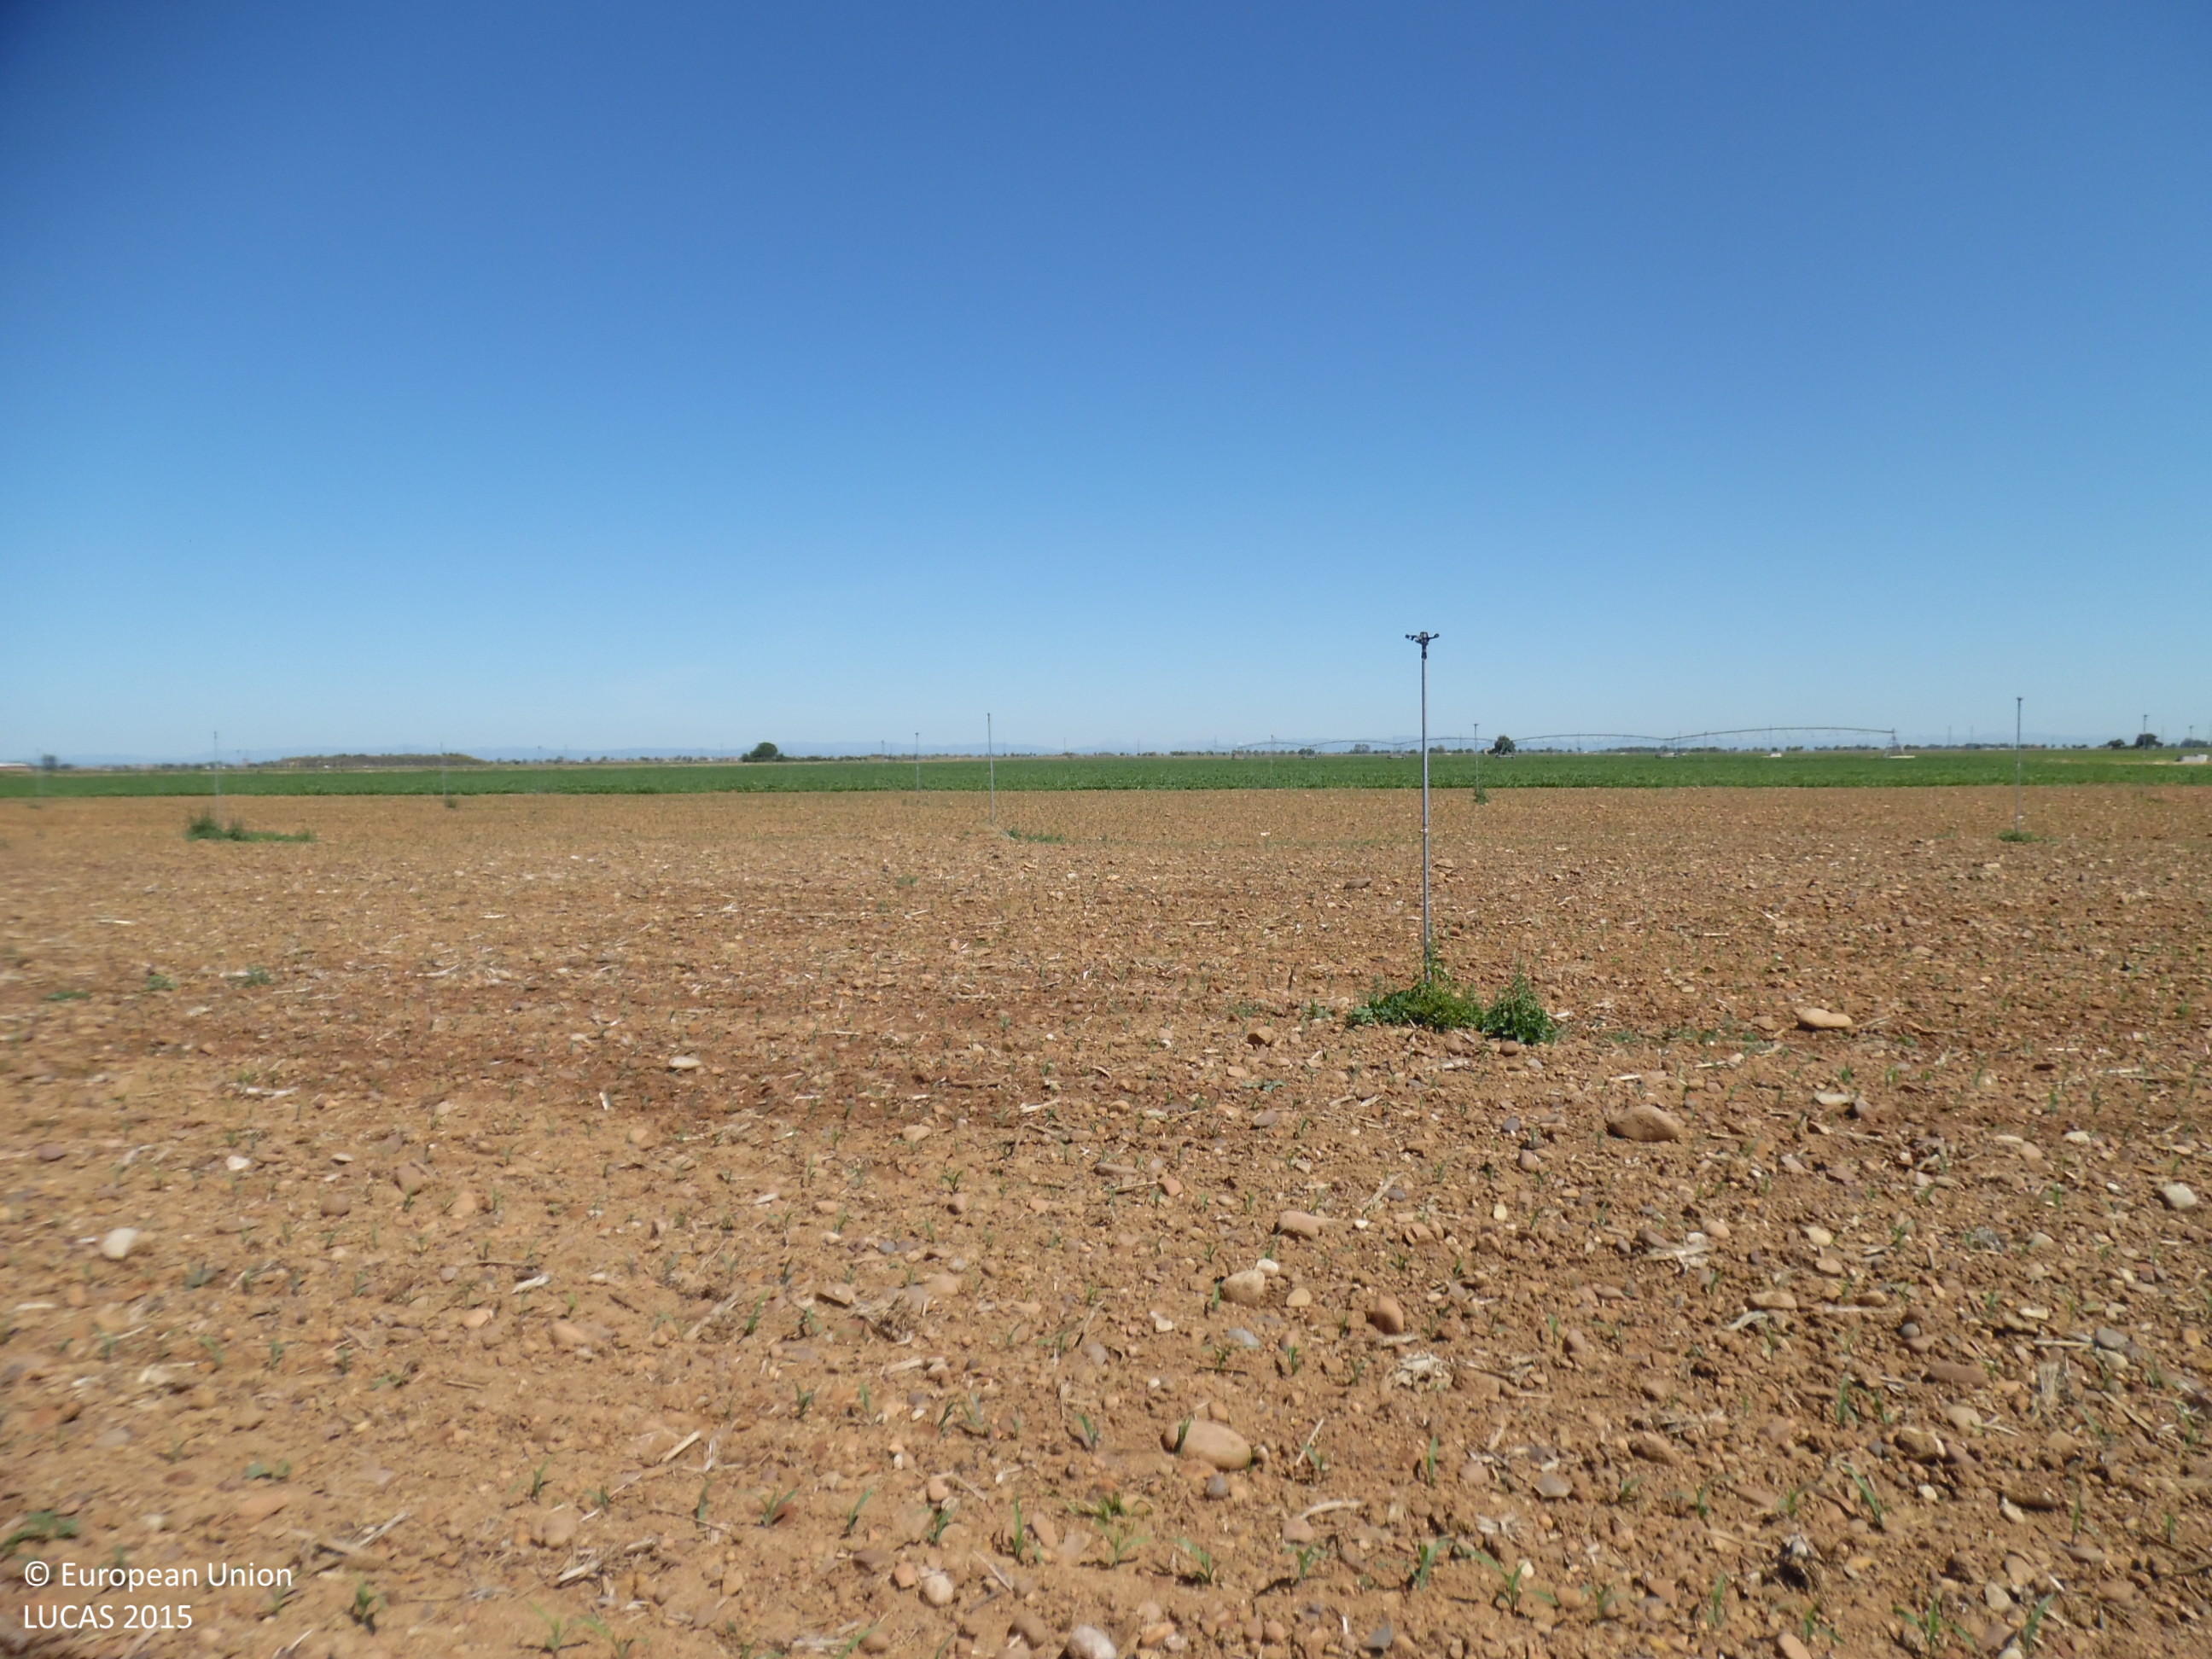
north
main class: Cropland
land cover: Maize
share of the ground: < 10 %
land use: Agriculture (excluding fallow land and kitchen gardens)
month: June
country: ES
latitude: 42.3010
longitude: -5.7078
